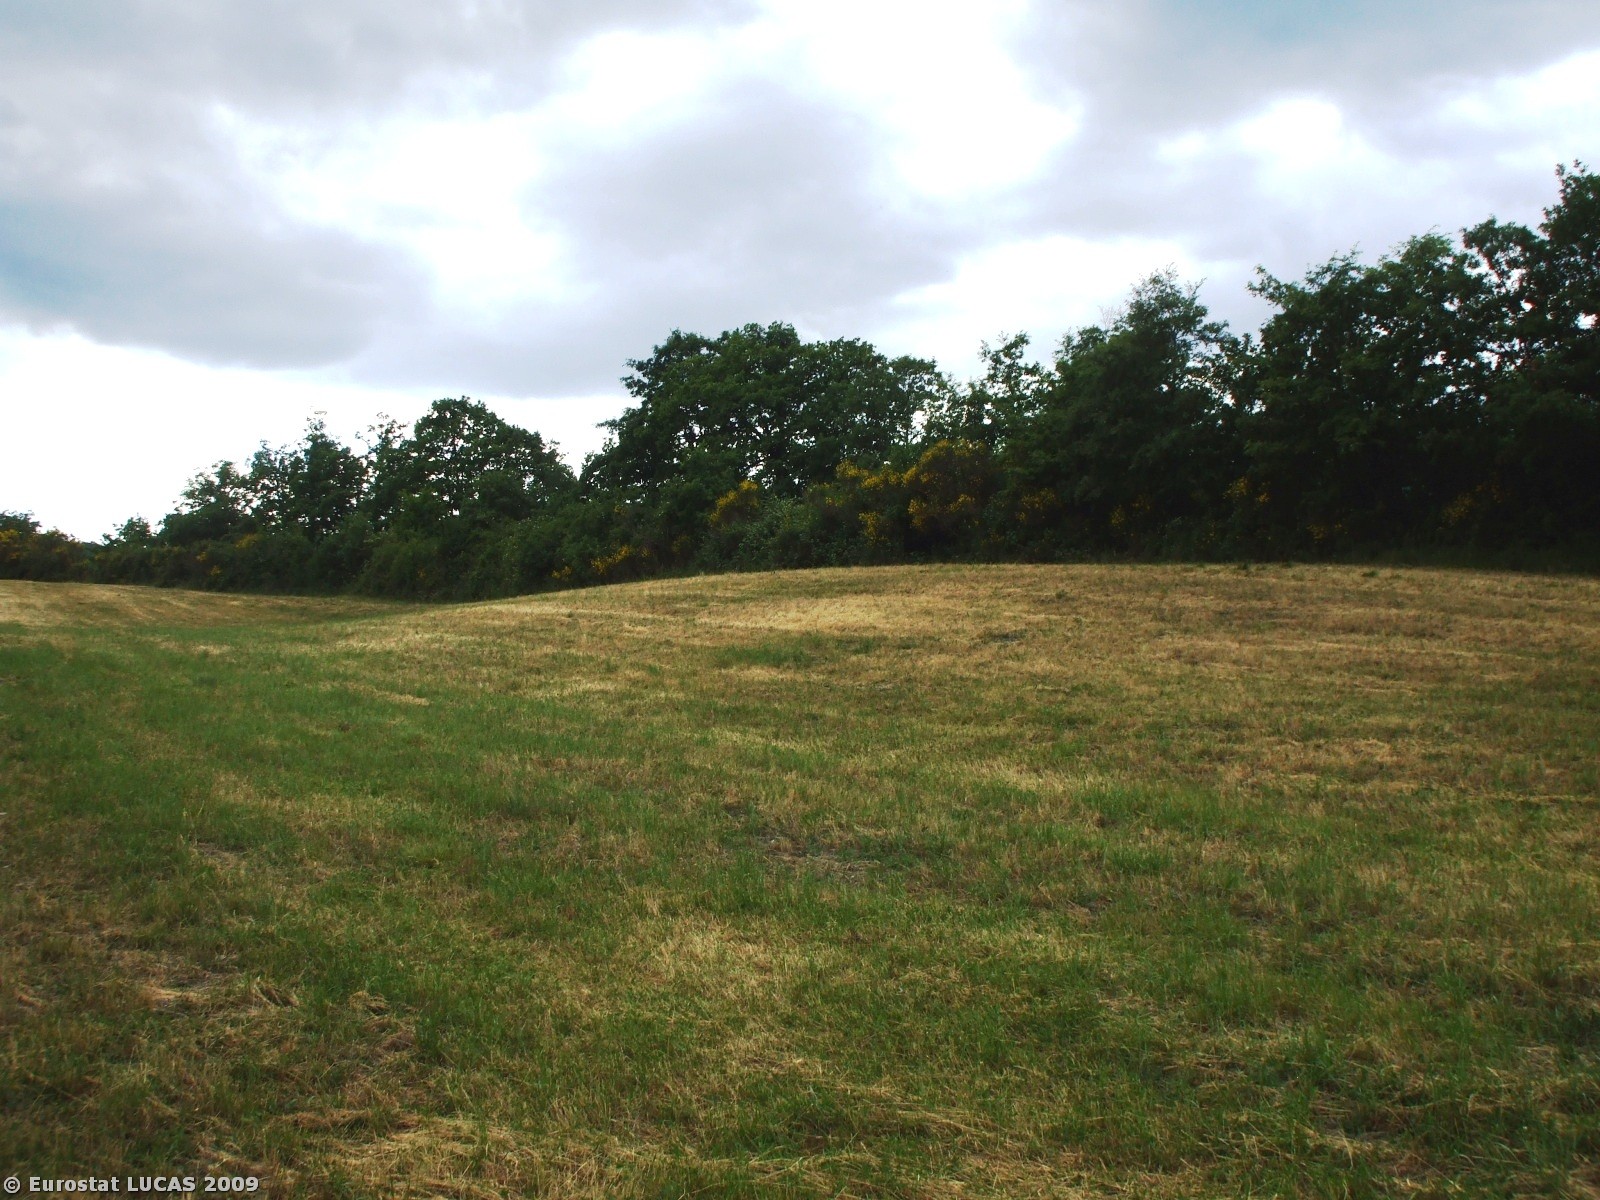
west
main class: Woodland
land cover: Broadleaved woodland
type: thermophilous deciduous forest
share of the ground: > 75 %
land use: Forestry
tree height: > 5 m
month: May
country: IT
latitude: 43.6092
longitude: 12.0142
